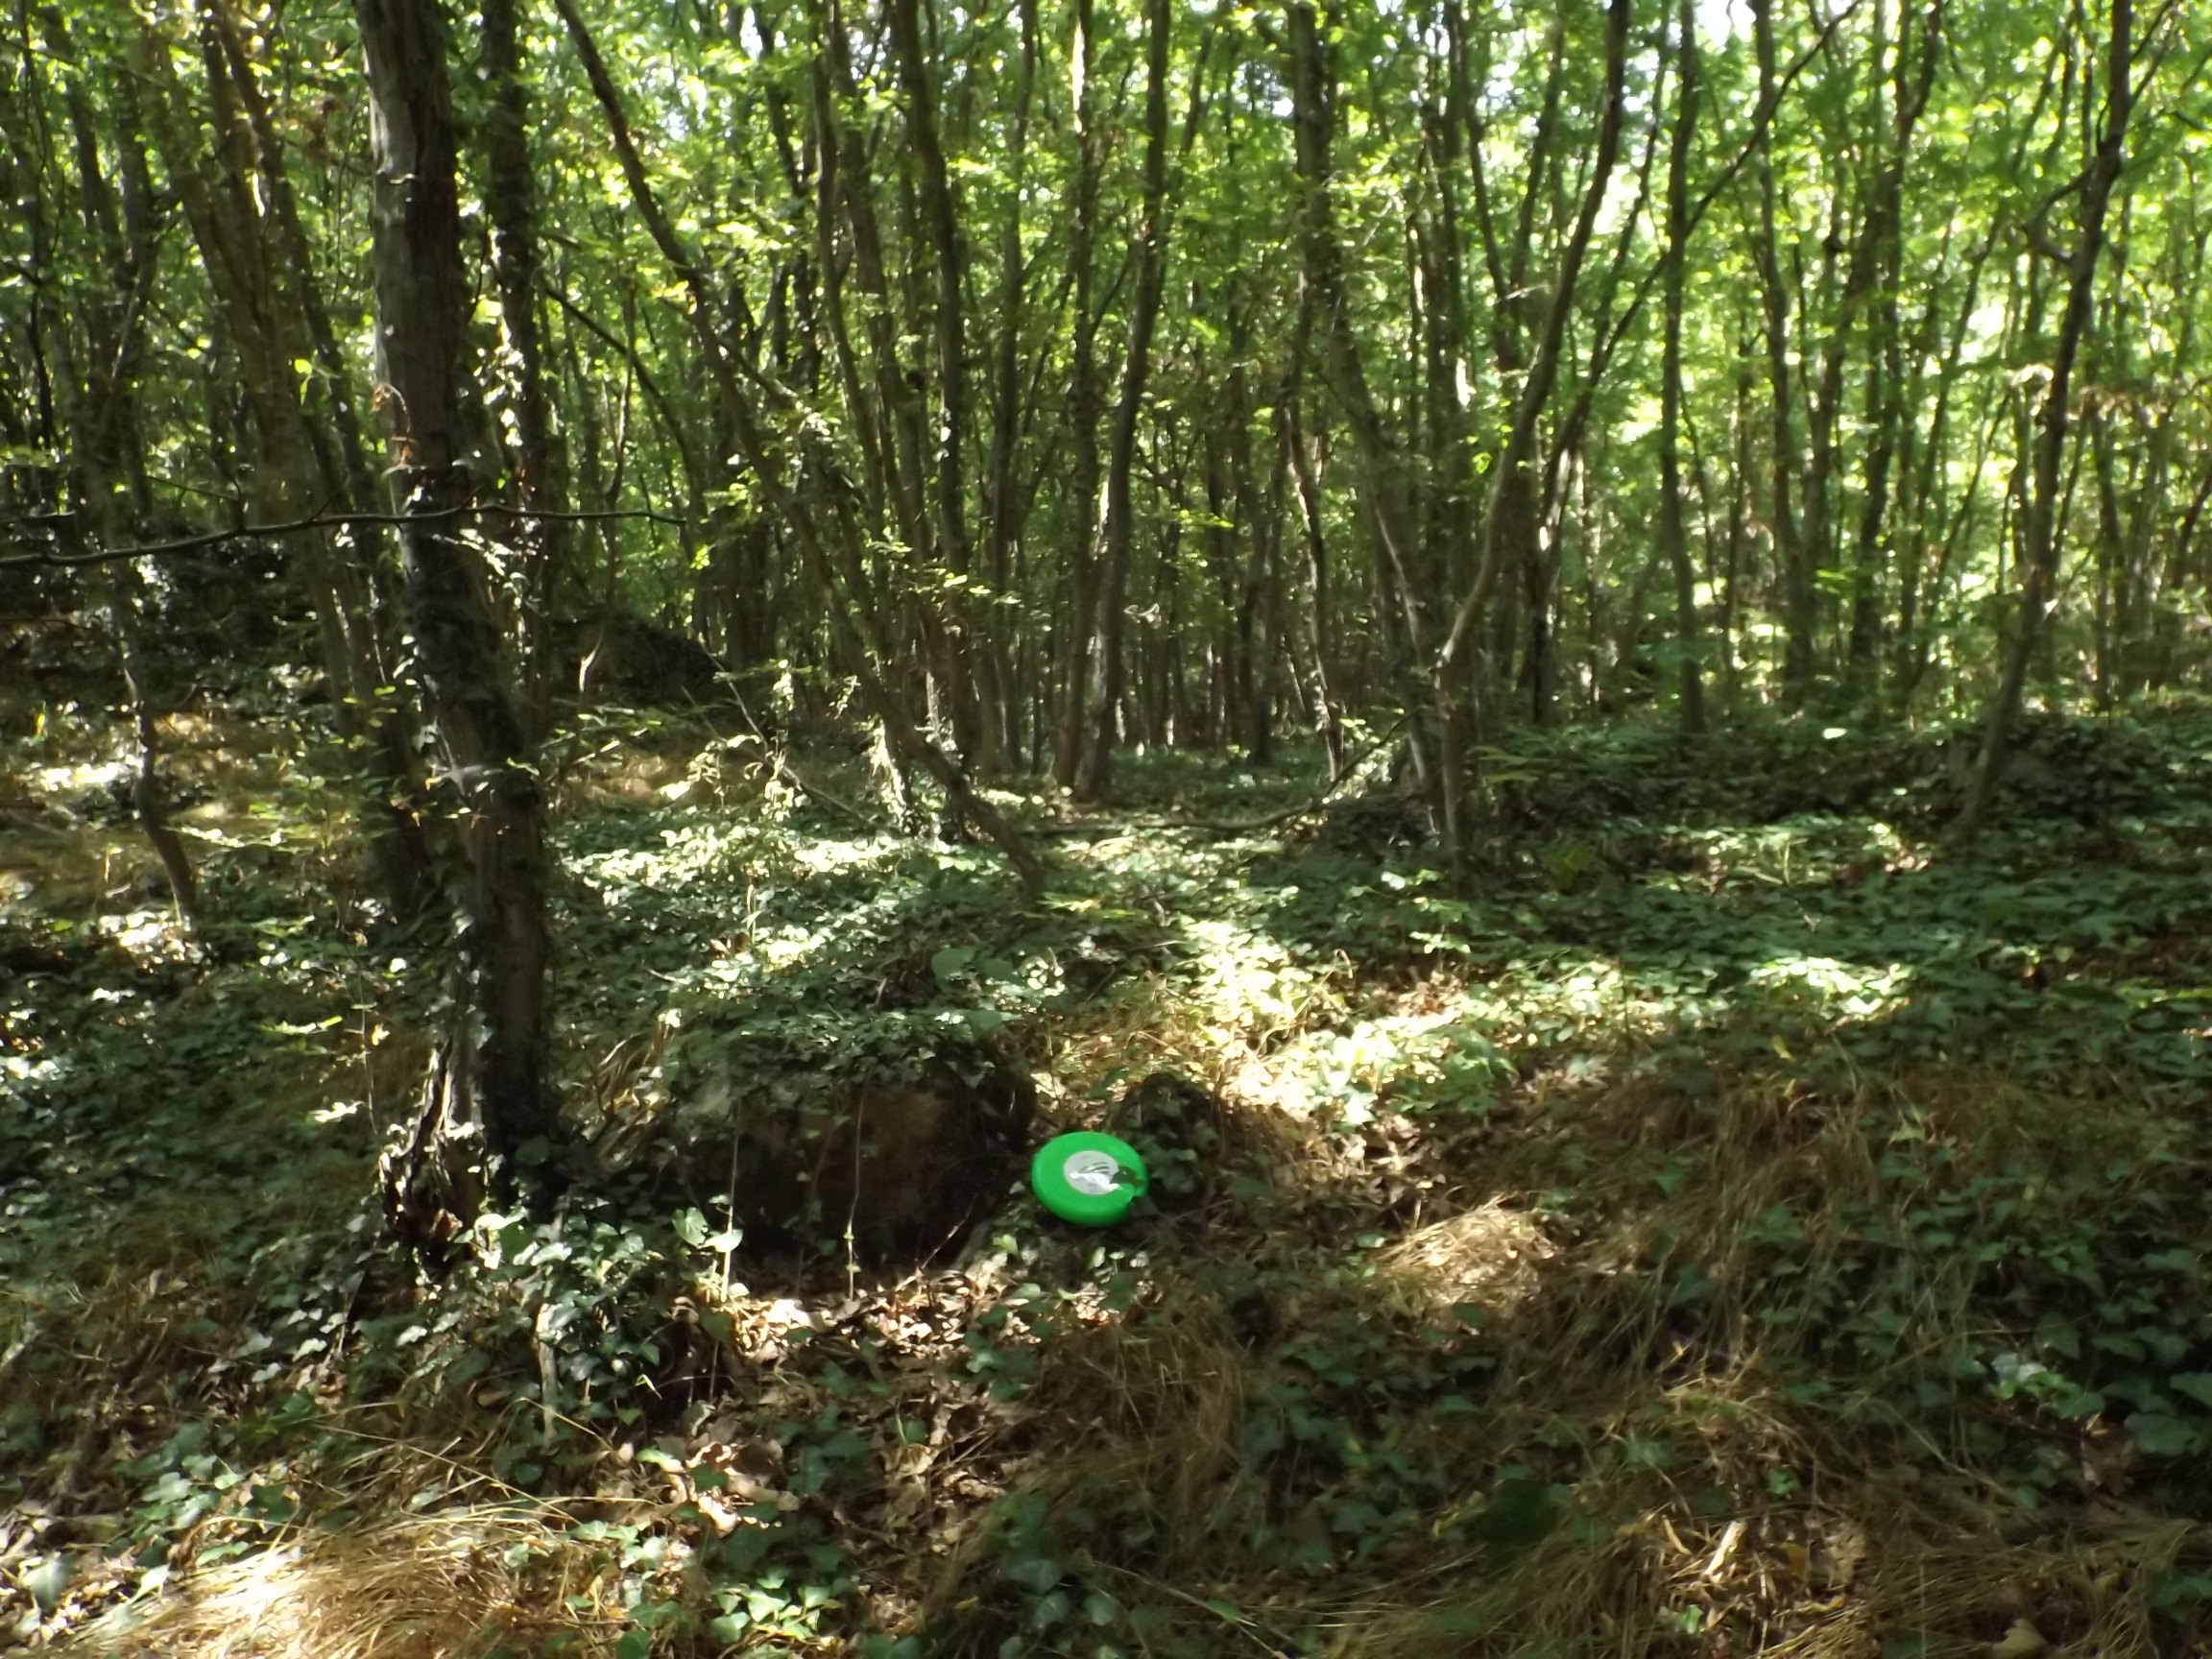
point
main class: Woodland
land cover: Broadleaved woodland
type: beech forest
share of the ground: > 75 %
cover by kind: broadleaved forest trees 100 %
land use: Forestry
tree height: > 5 m
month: August
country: BG
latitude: 43.2731
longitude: 28.0216
